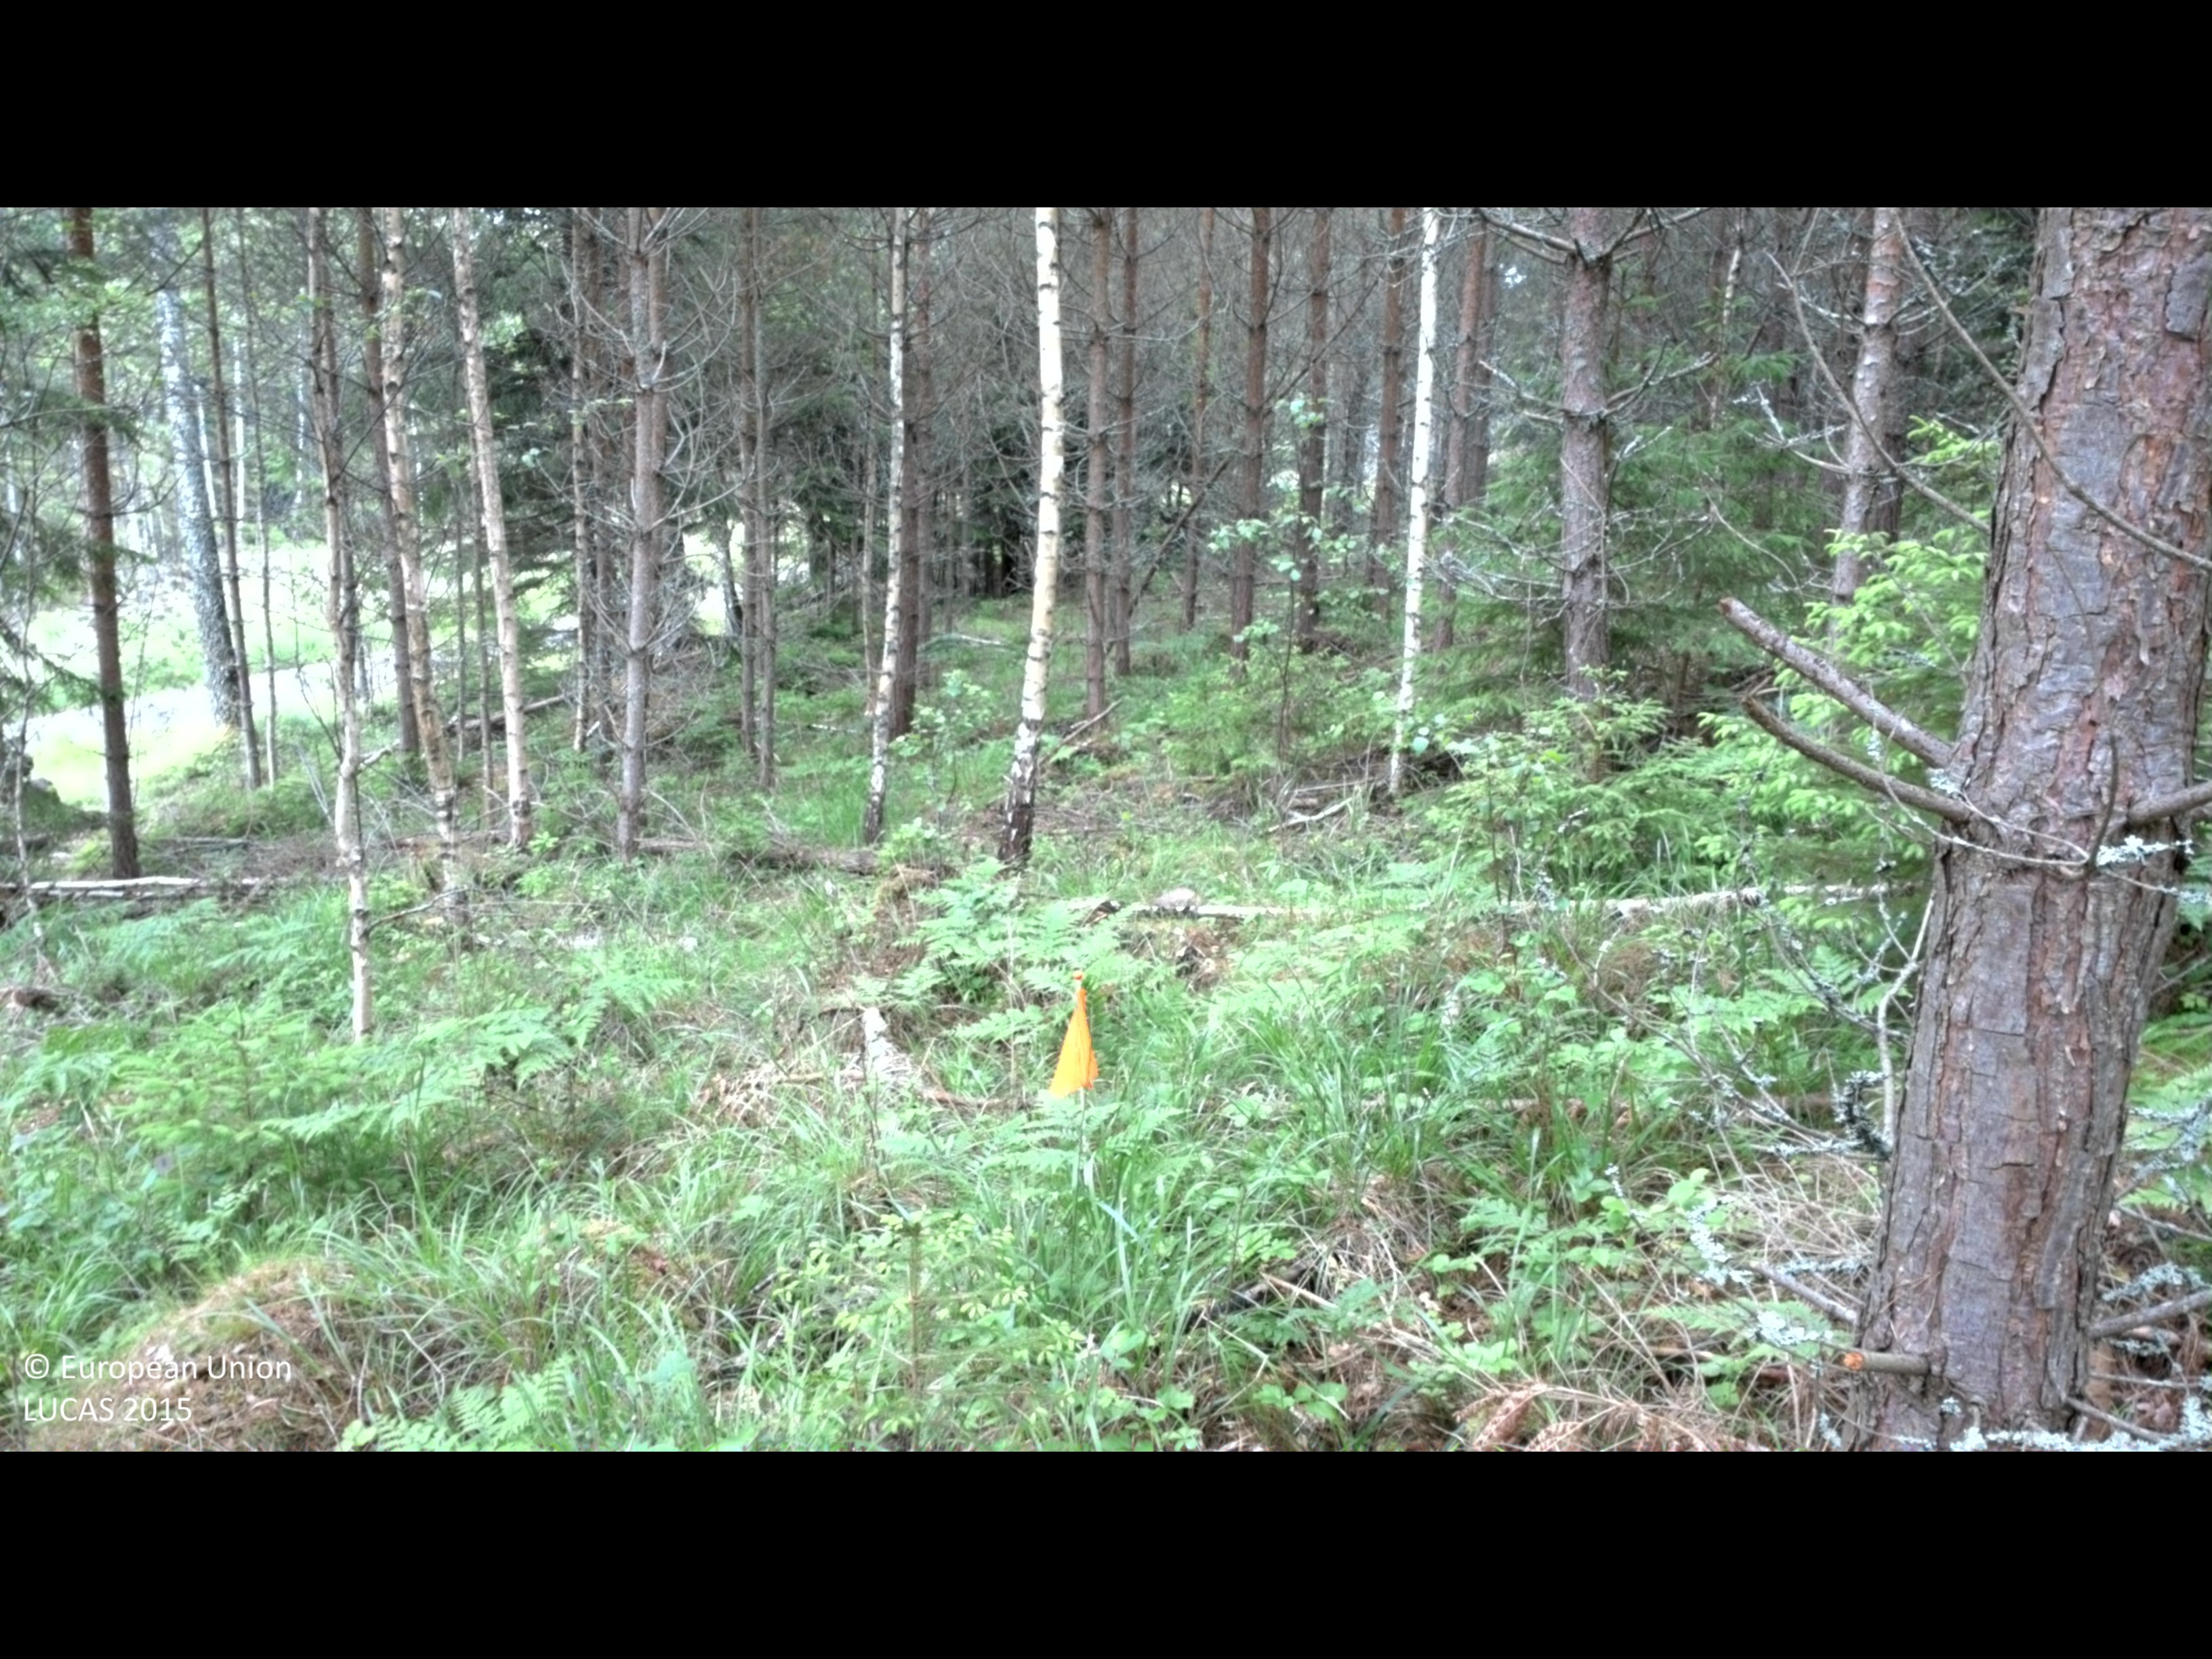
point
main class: Woodland
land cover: Pine dominated coniferous woodland
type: boreal forest
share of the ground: > 75 %
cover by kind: coniferous forest trees 65 %, broadleaved forest trees 15 %, shrubs 15 %, herbaceous plants 5 %
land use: Forestry
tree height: > 5 m
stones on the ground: 25 - 50 %
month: June
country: SE
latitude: 58.0024
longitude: 16.2406
